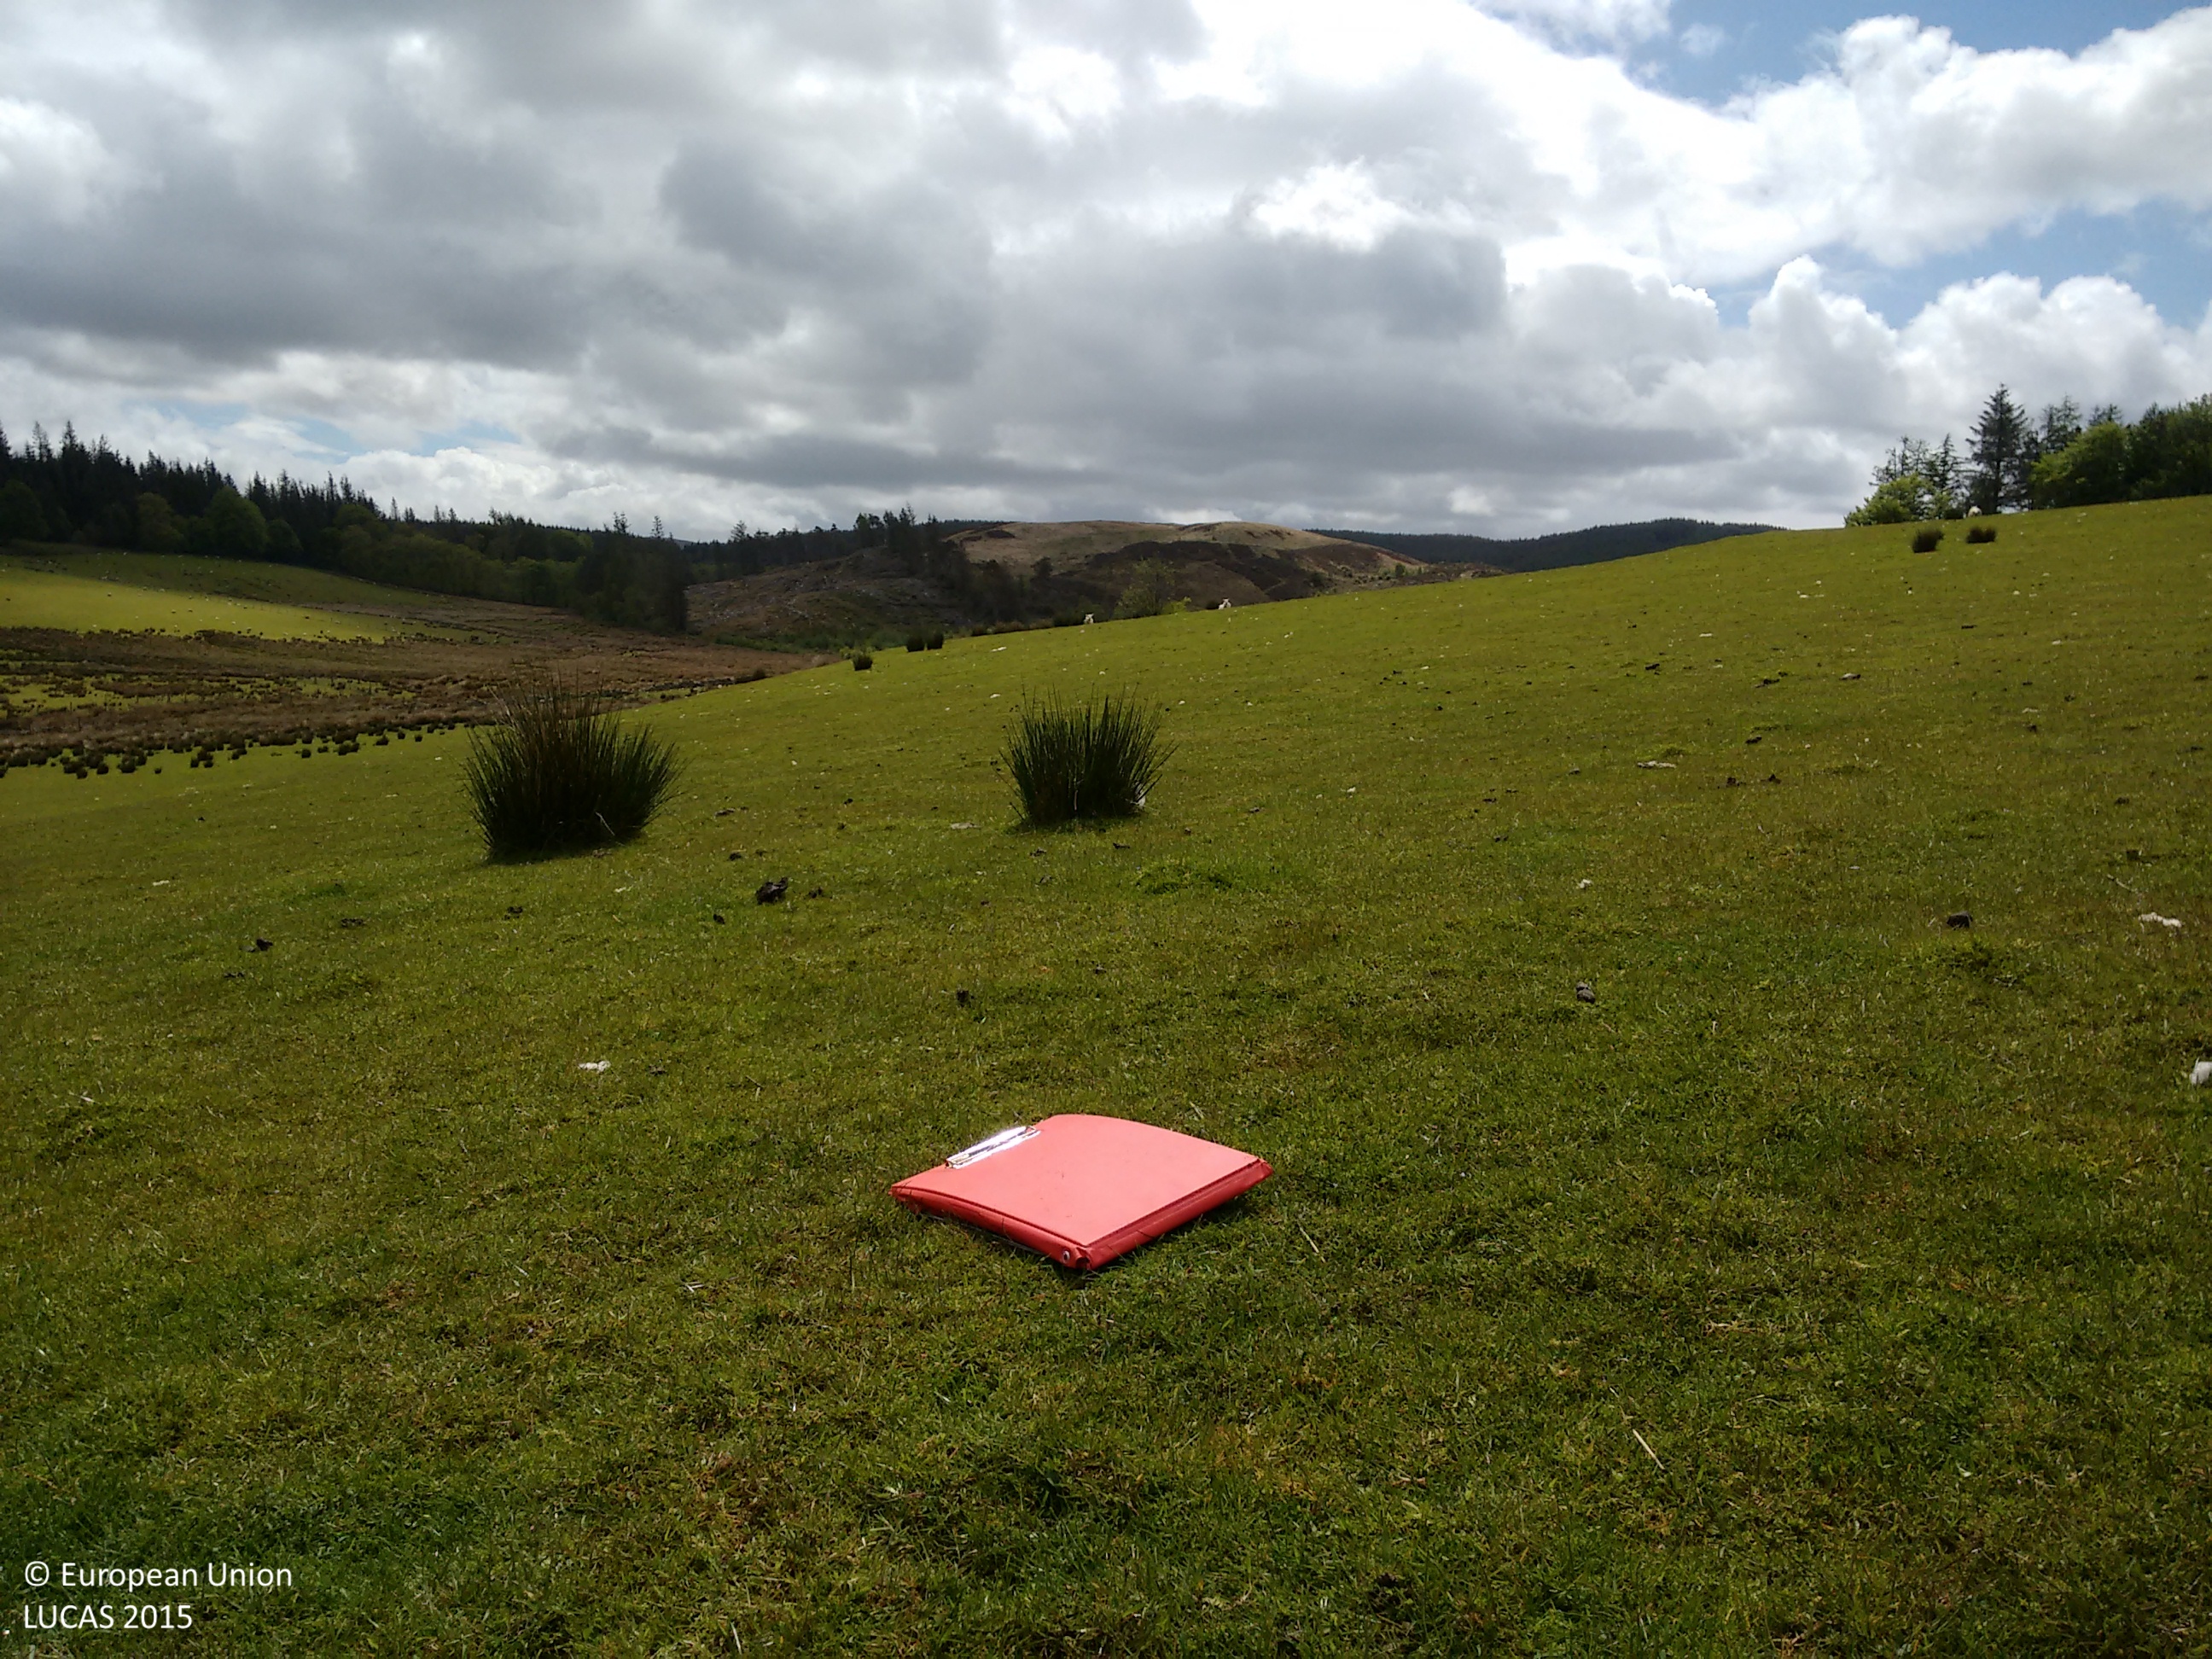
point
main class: Grassland
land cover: Grassland without tree/shrub cover
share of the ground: > 75 %
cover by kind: herbaceous plants 100 %
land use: Agriculture (excluding fallow land and kitchen gardens)
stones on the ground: < 10 %
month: May
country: GB
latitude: 55.9920
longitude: -5.3319
